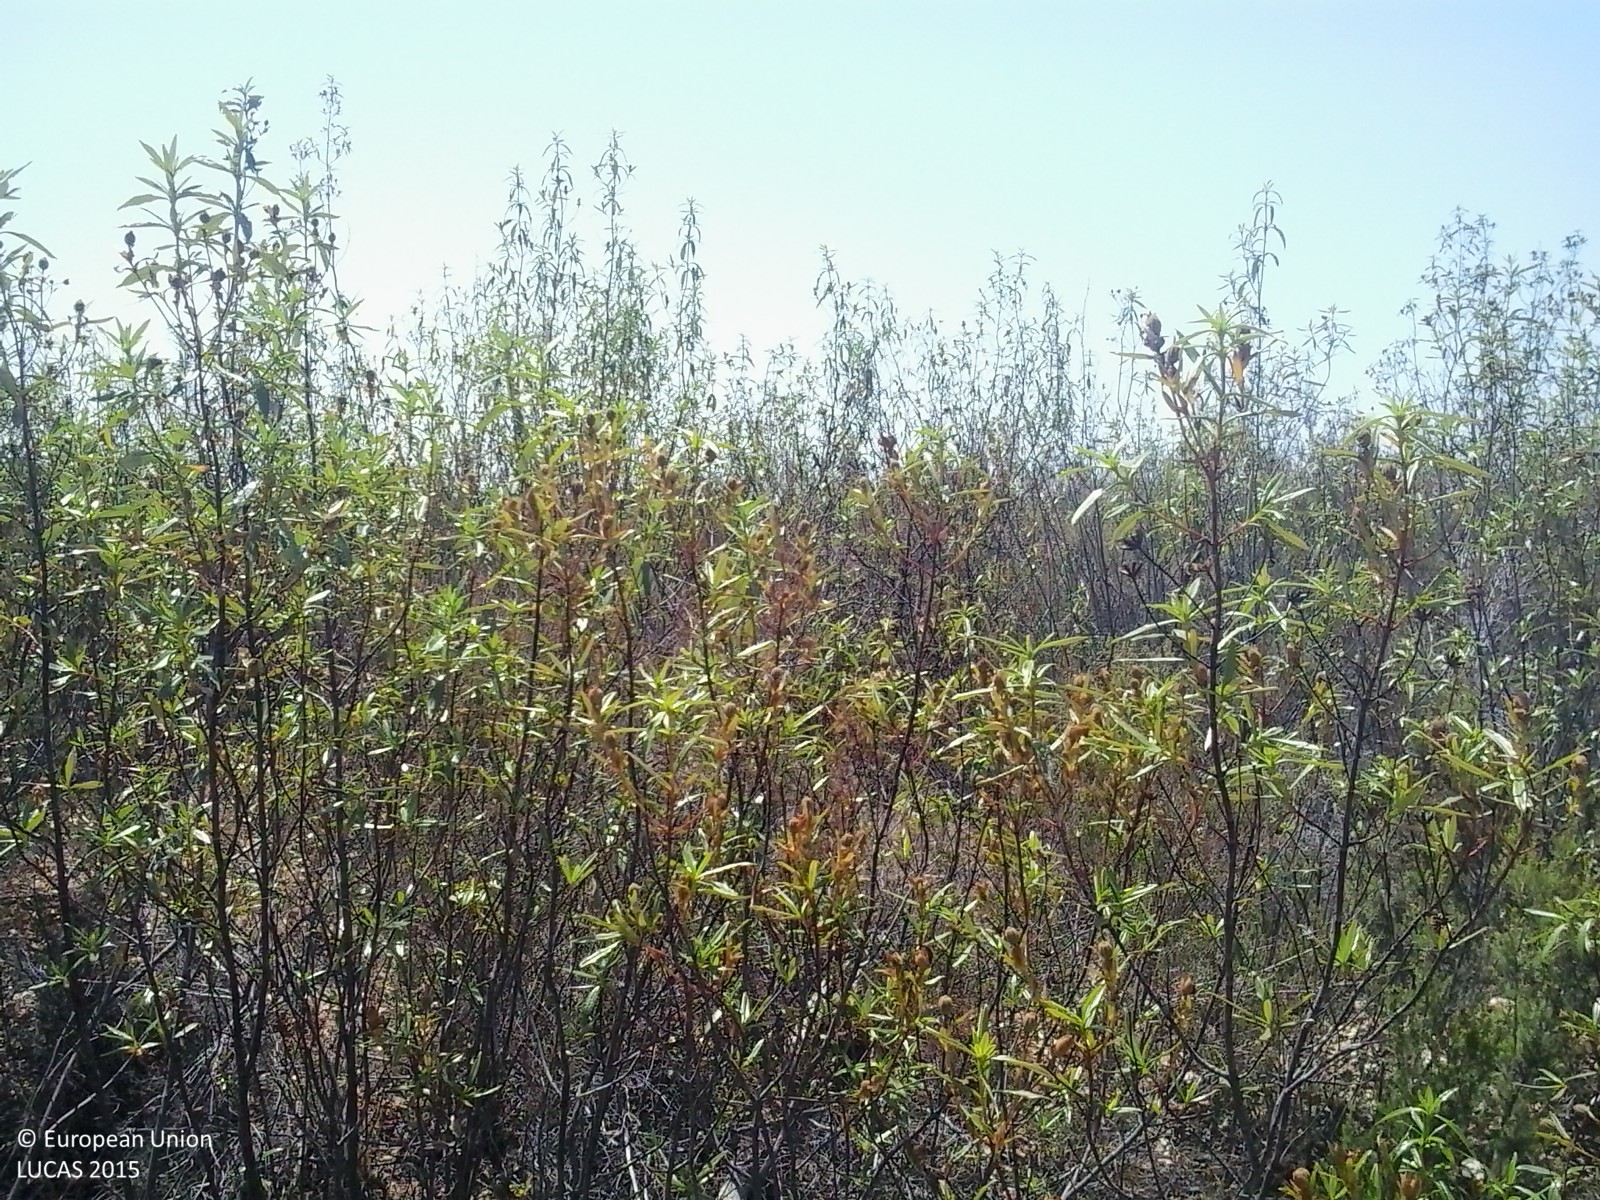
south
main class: Shrubland
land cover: Shrubland without tree cover
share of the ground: > 75 %
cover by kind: shrubs 90 %, herbaceous plants 5 %, unconsolidated bare surface 5 %
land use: Forestry
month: July
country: ES
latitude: 37.5573
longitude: -6.4606
